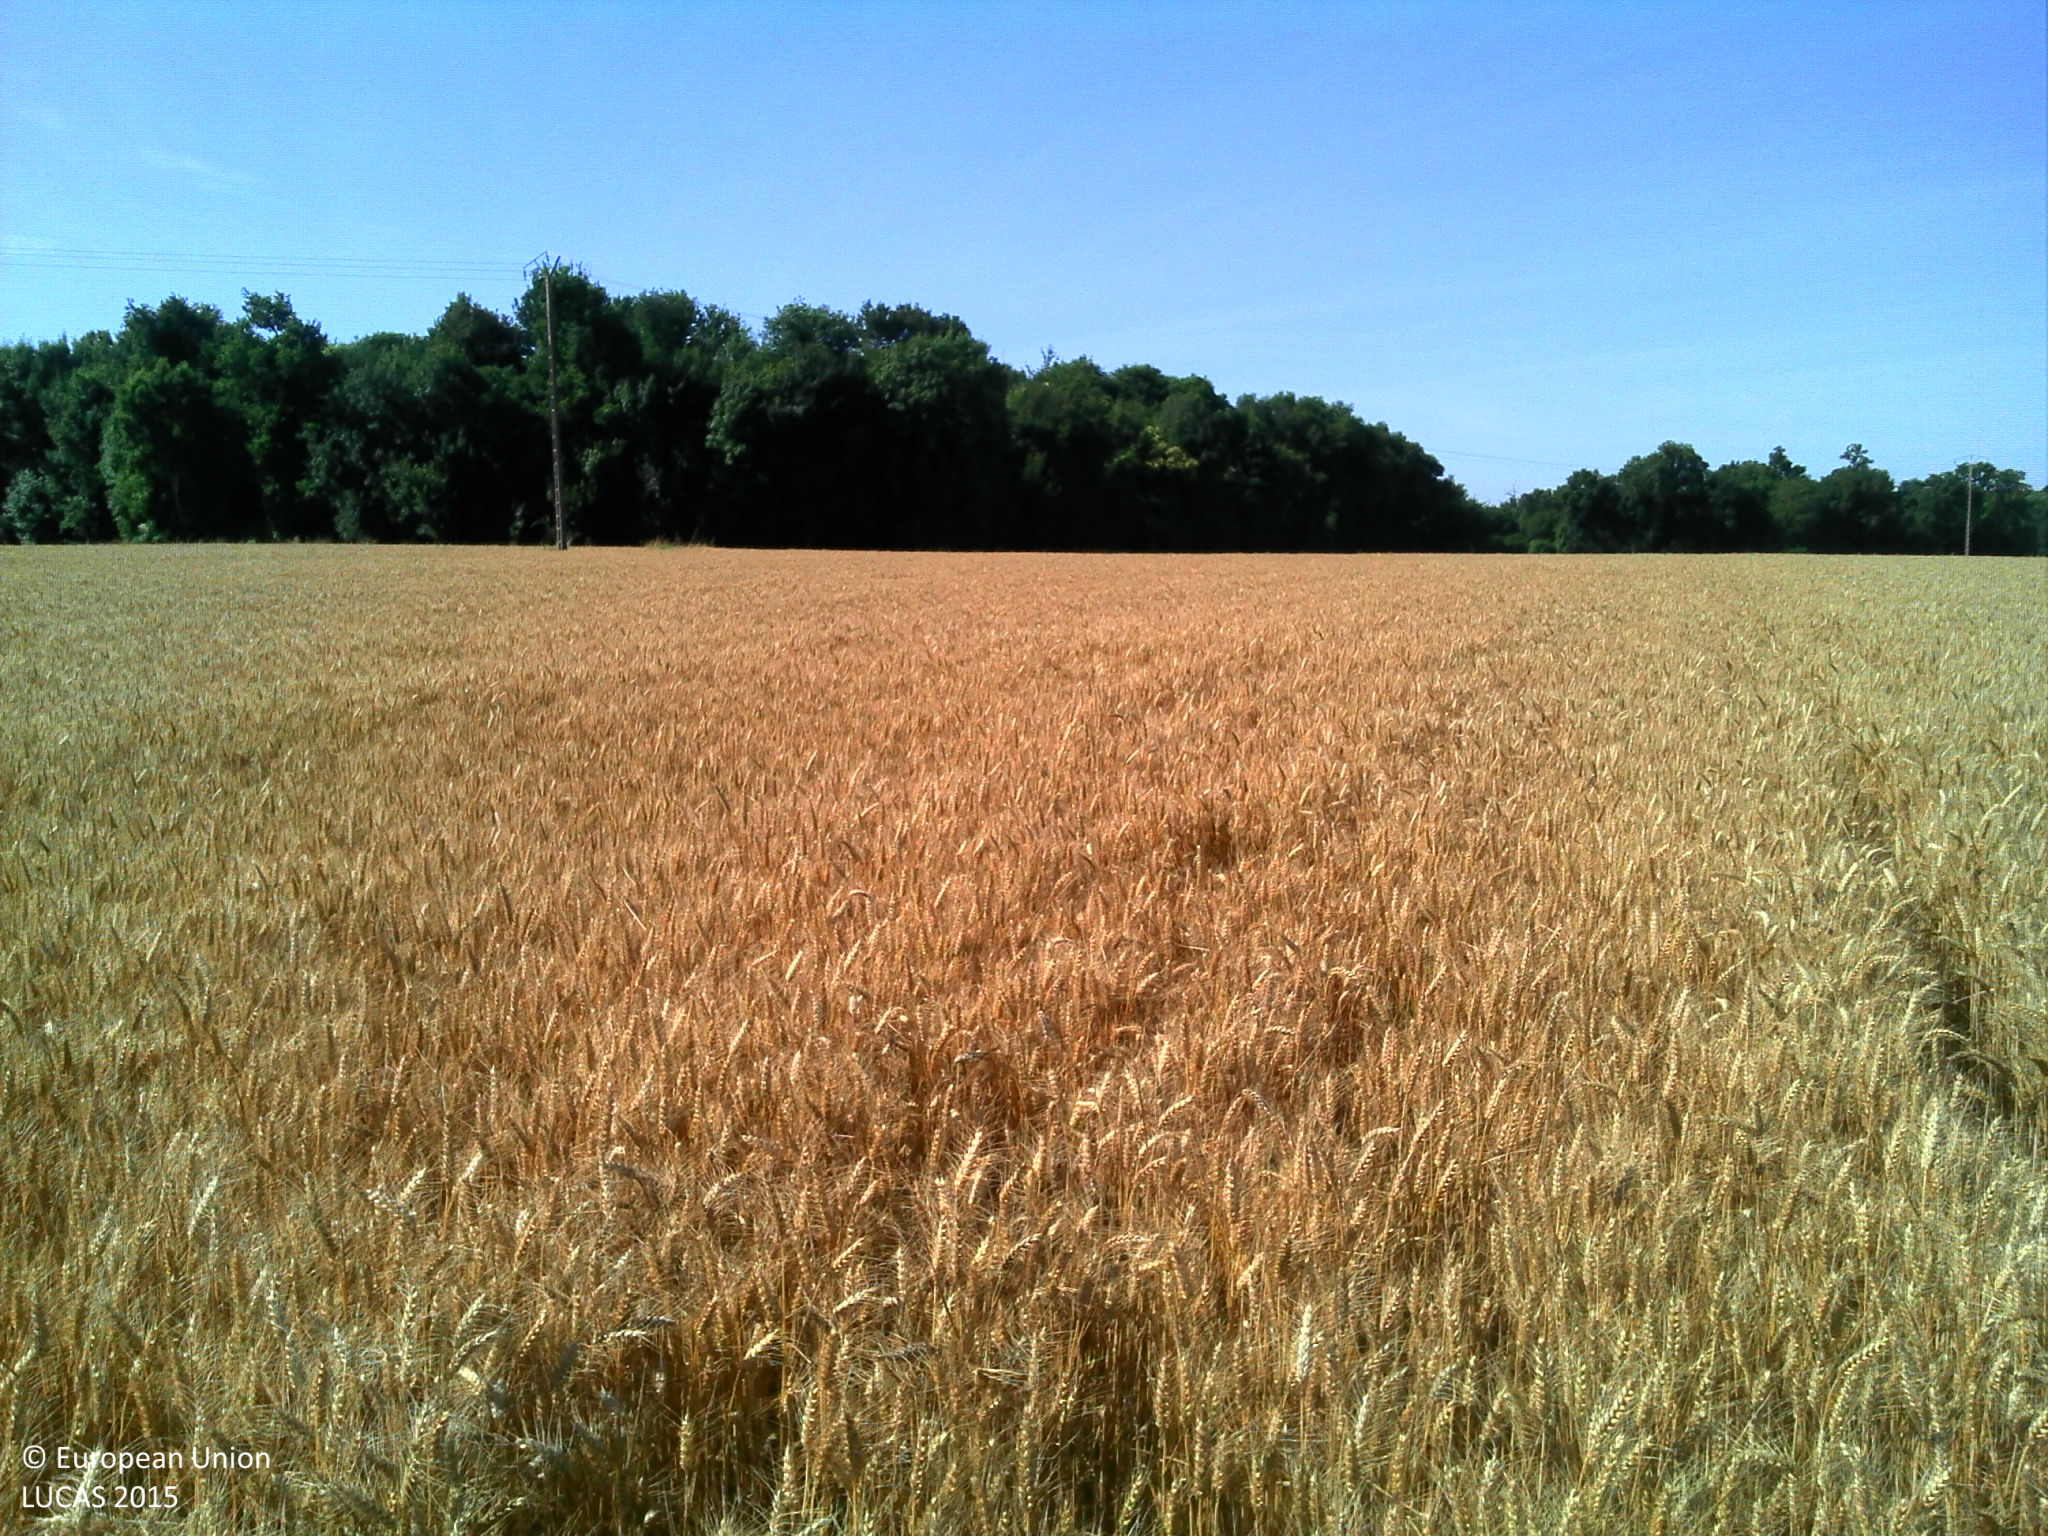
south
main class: Cropland
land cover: Durum wheat
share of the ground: > 75 %
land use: Agriculture (excluding fallow land and kitchen gardens)
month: June
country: FR
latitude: 45.8109
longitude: -0.7192
